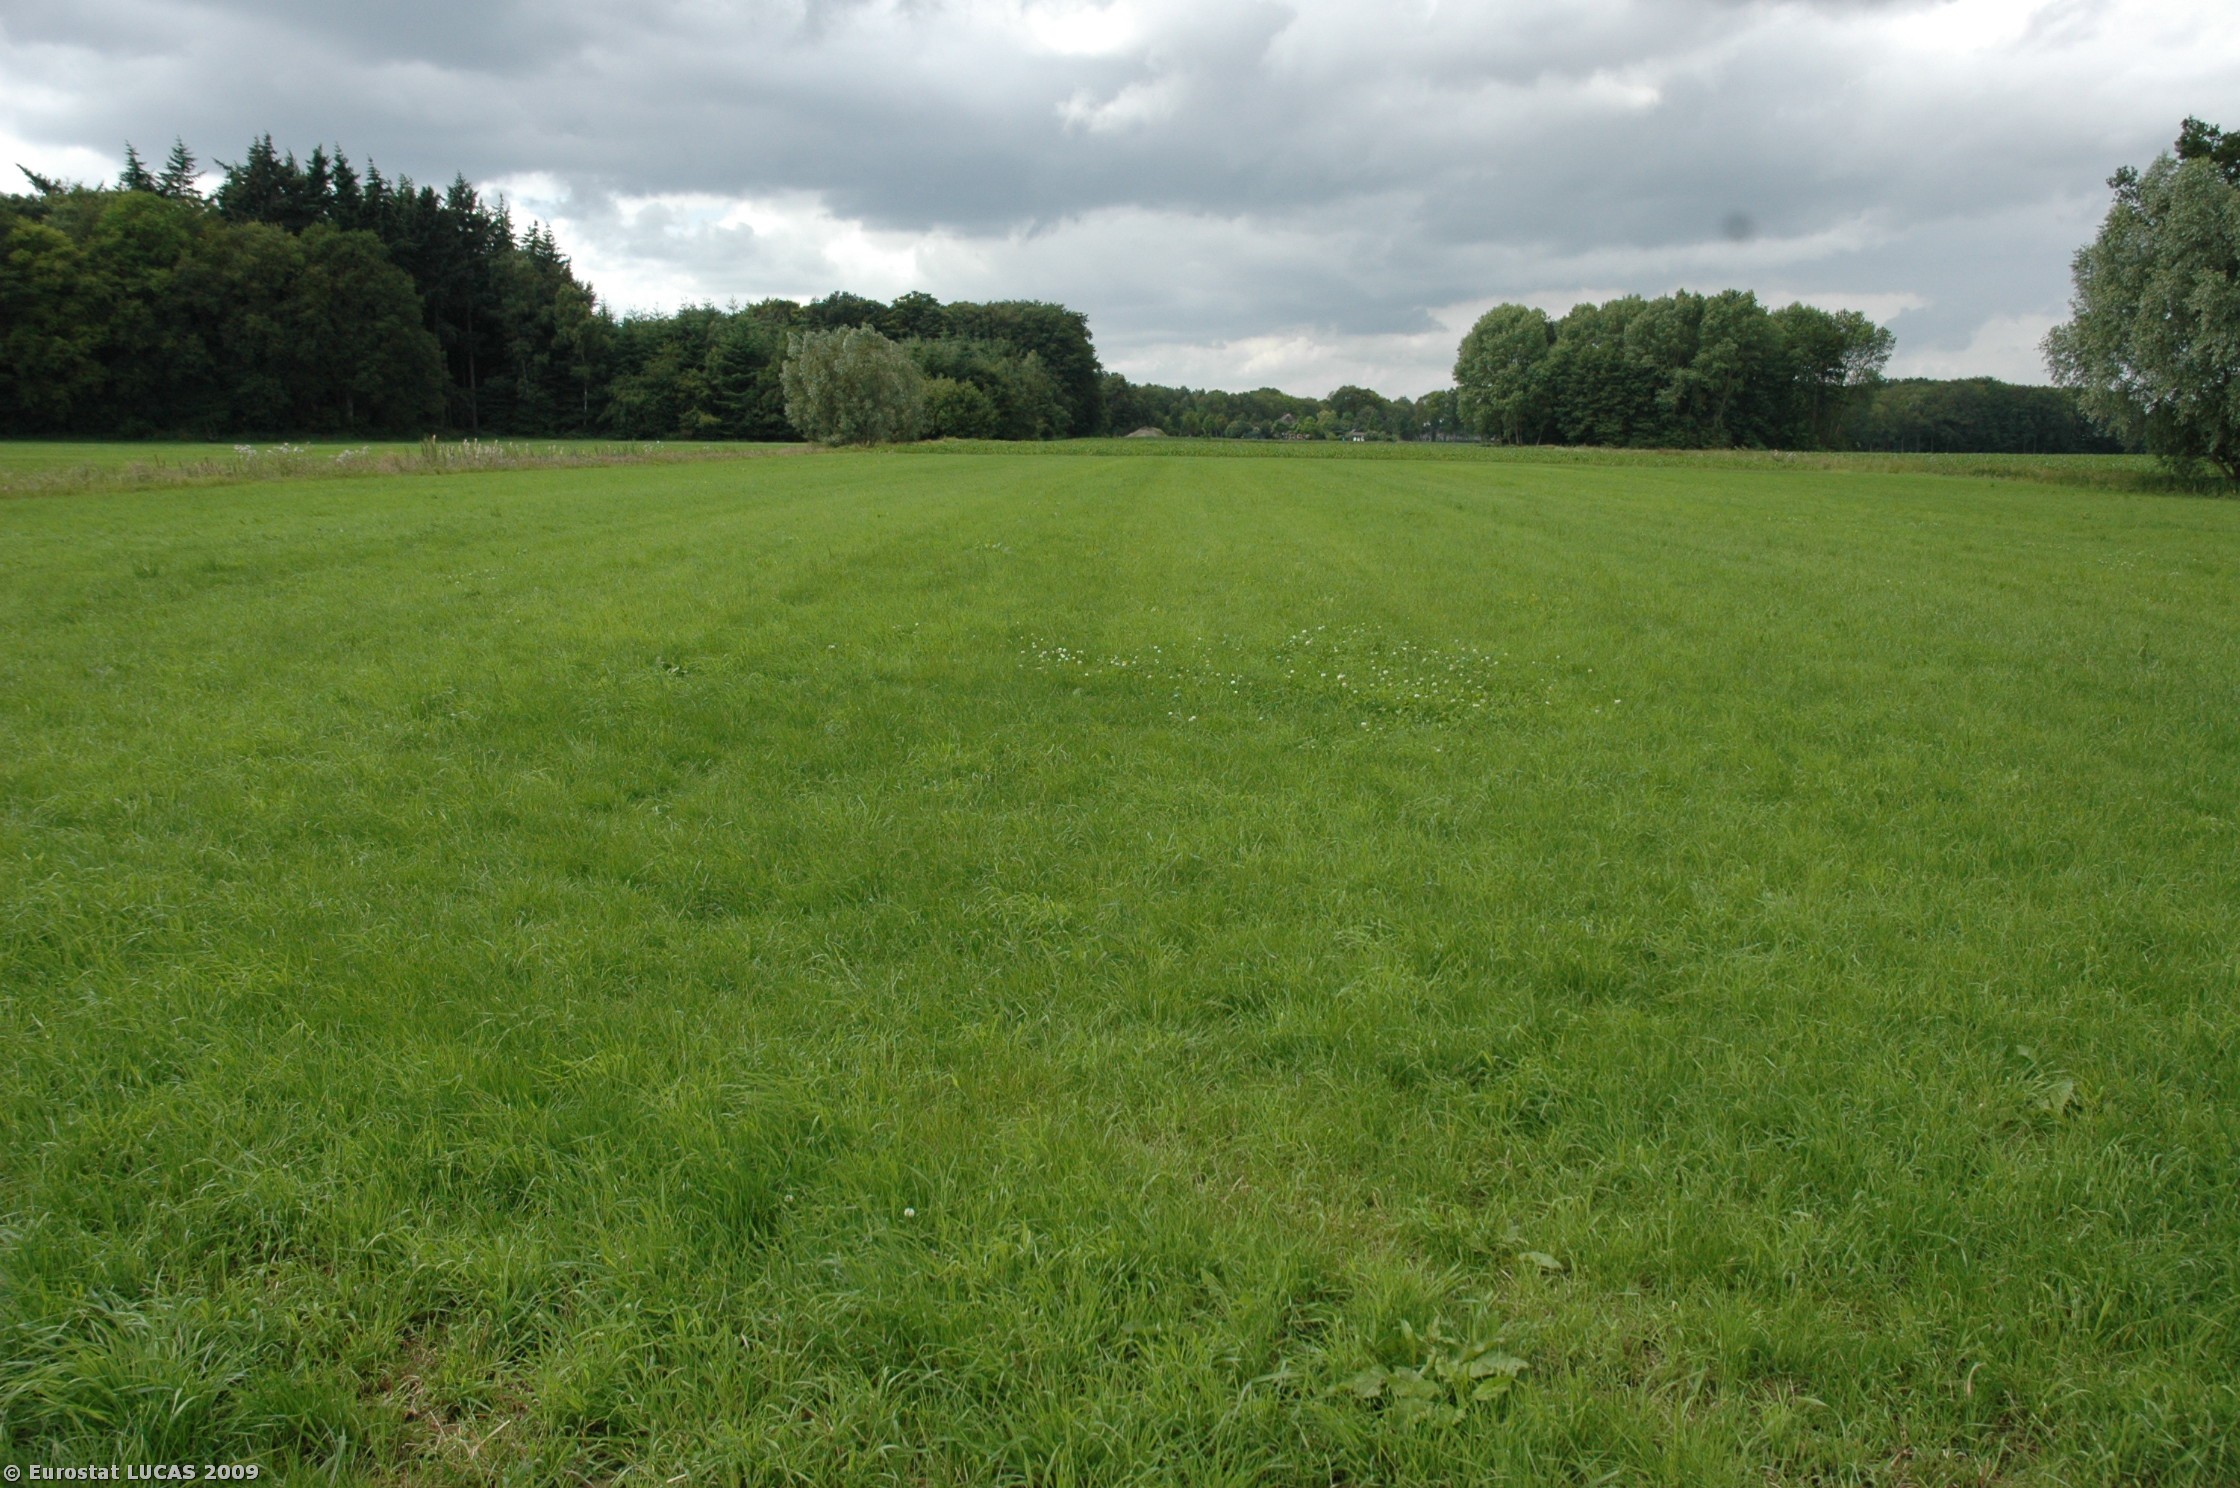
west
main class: Grassland
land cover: Grassland without tree/shrub cover
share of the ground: > 75 %
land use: Agriculture (excluding fallow land and kitchen gardens)
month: June
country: NL
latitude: 52.2411
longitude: 6.0891
